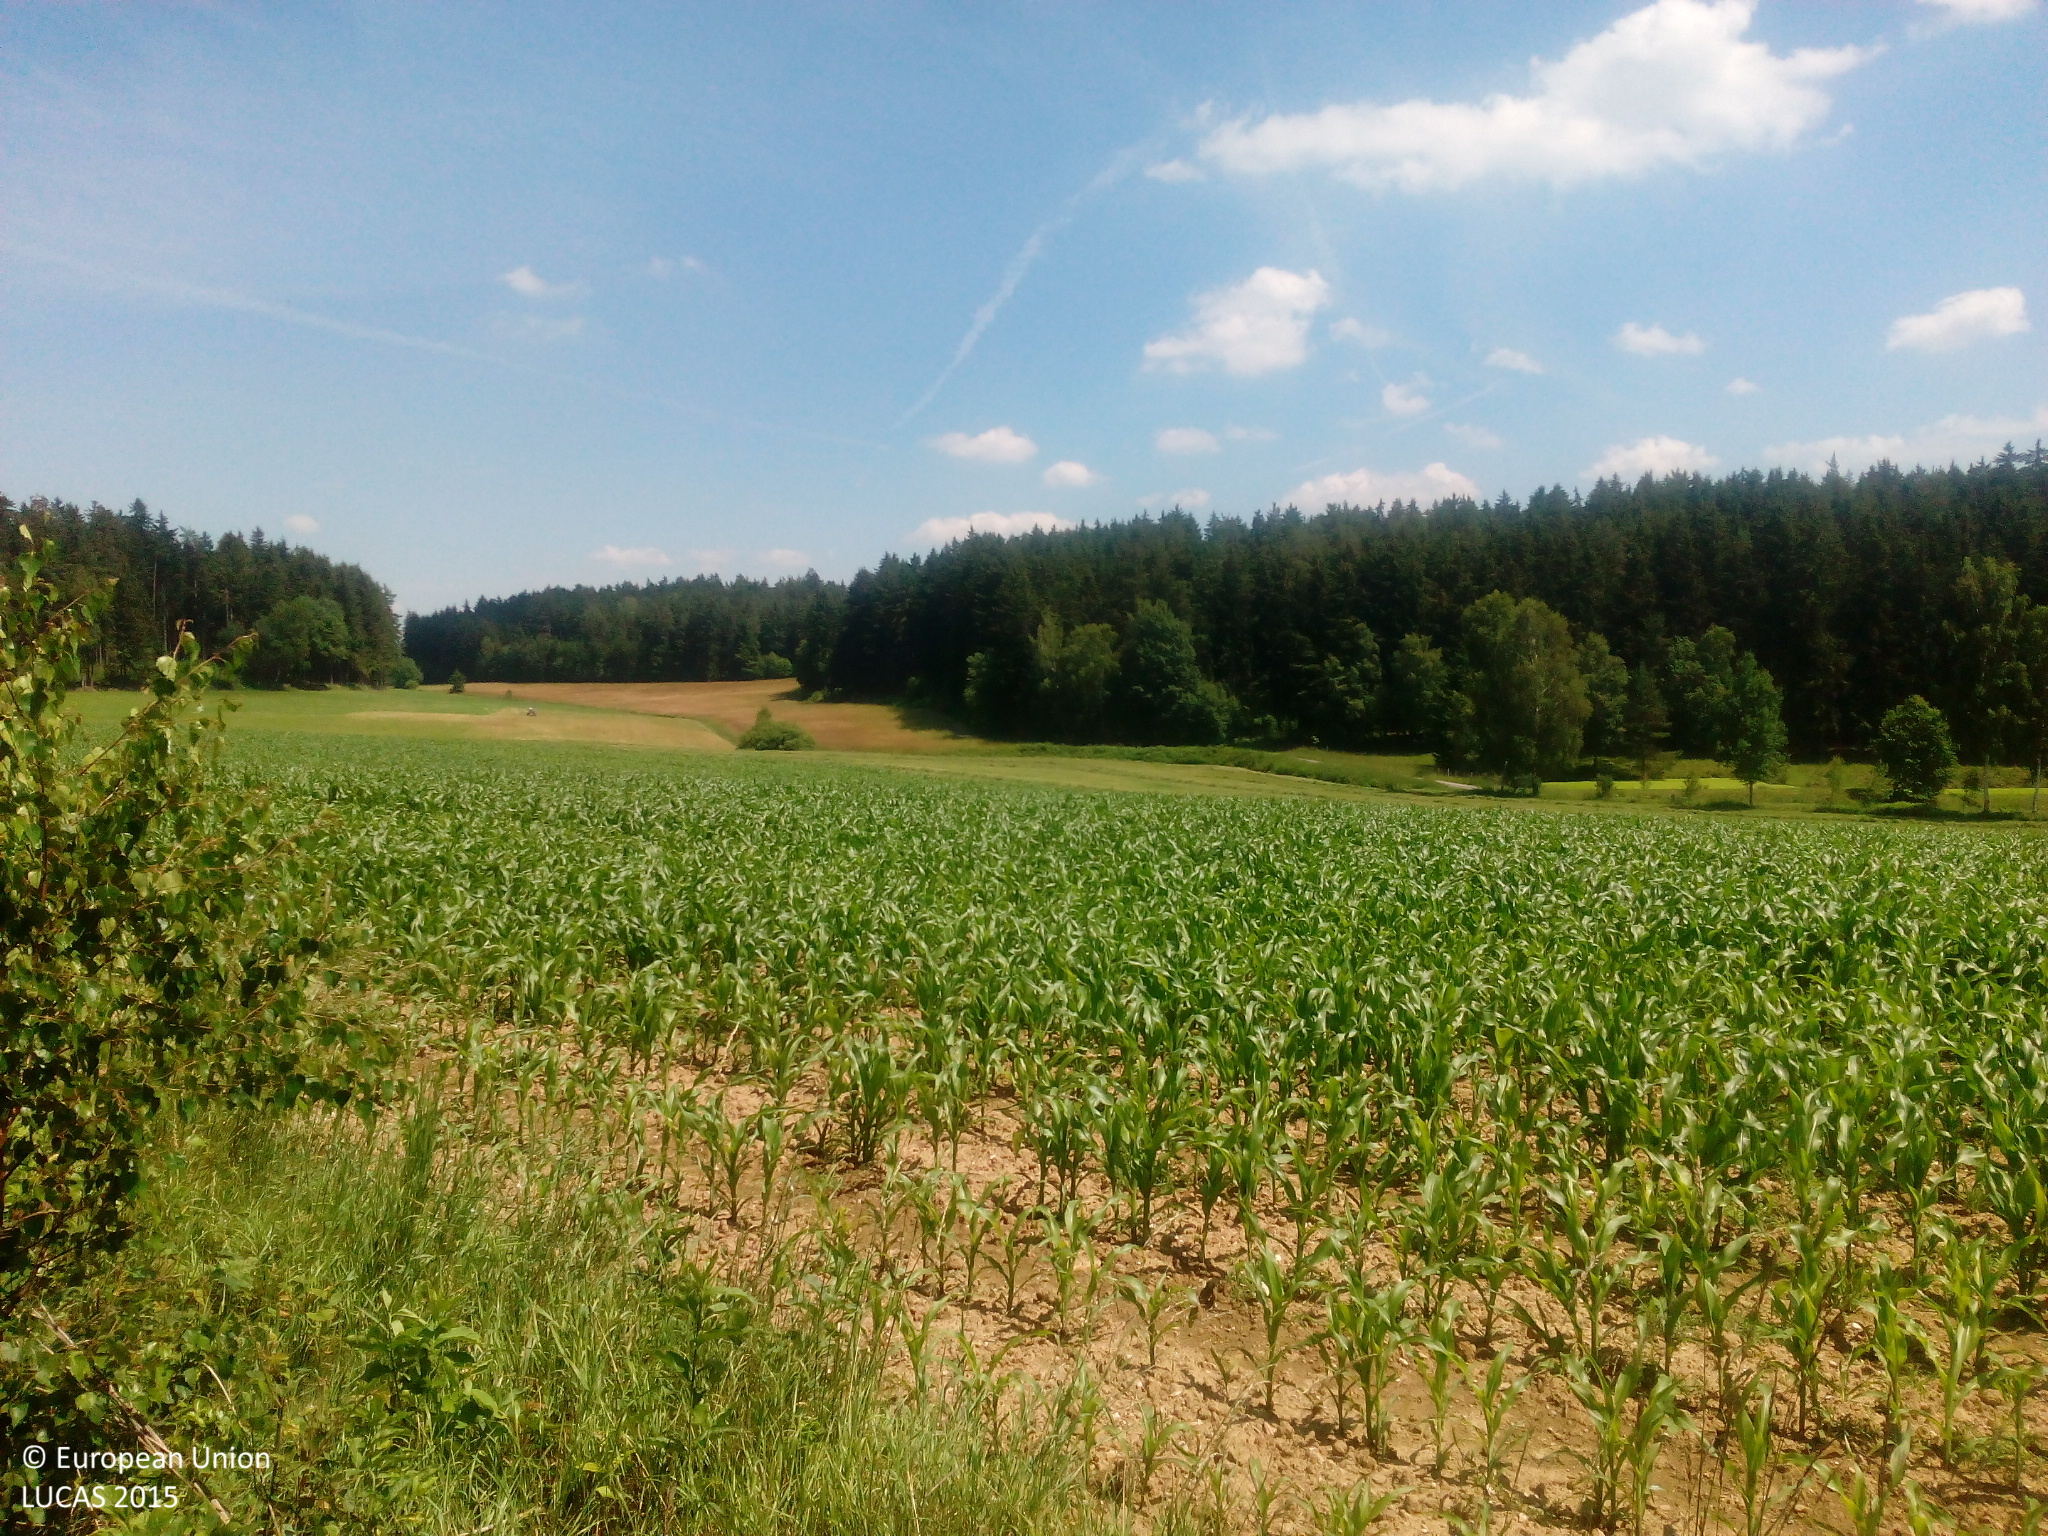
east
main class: Woodland
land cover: Broadleaved woodland
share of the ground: 25 - 50 %
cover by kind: herbaceous plants 75 %, broadleaved forest trees 25 %
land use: Road transport
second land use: Agriculture (excluding fallow land and kitchen gardens)
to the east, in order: Broadleaved woodland; Grass margins; Maize; Grassland without tree/shrub cover; Shruby margins; Rivers and streams; Shruby margins; Grassland without tree/shrub cover
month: June
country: DE
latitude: 50.1482
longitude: 12.0288
